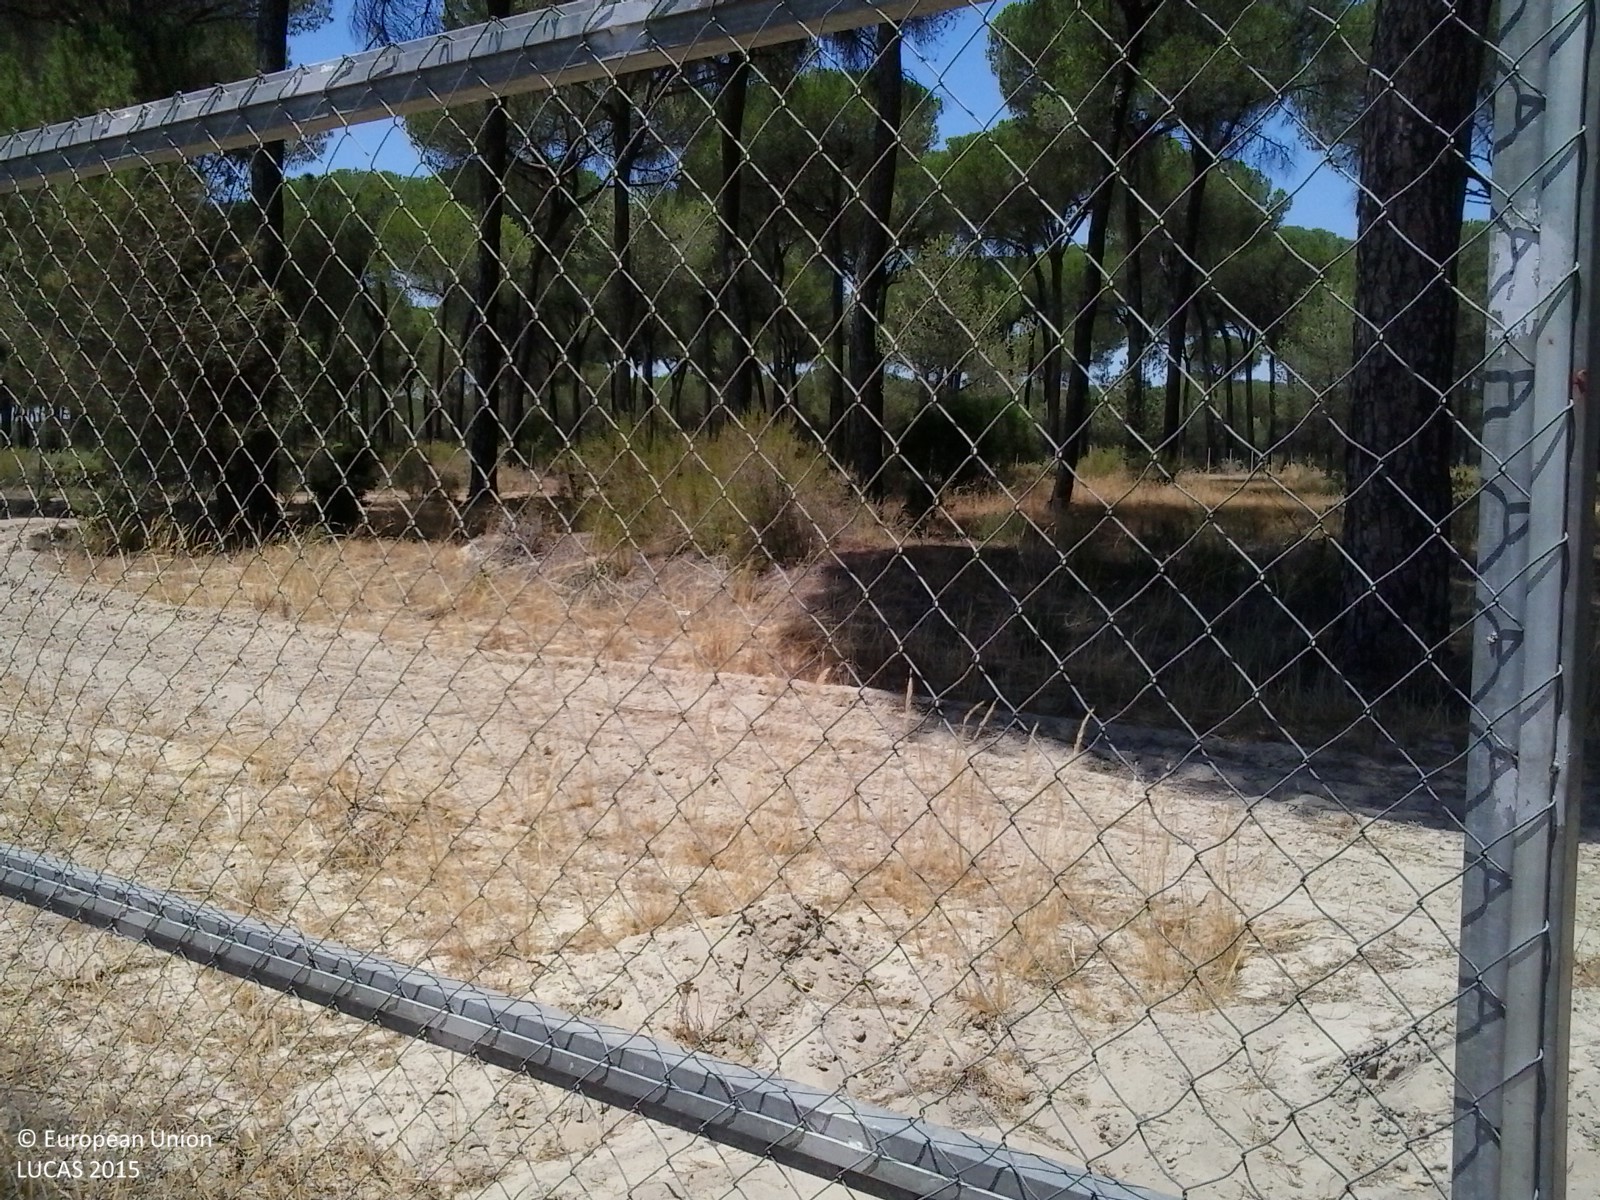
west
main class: Woodland
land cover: Pine dominated coniferous woodland
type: coniferous forest of the mediterranean region
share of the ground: 50 - 75 %
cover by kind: coniferous forest trees 50 %, herbaceous plants 30 %, shrubs 20 %
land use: Forestry
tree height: > 5 m
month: July
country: ES
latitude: 37.2034
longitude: -6.3751
